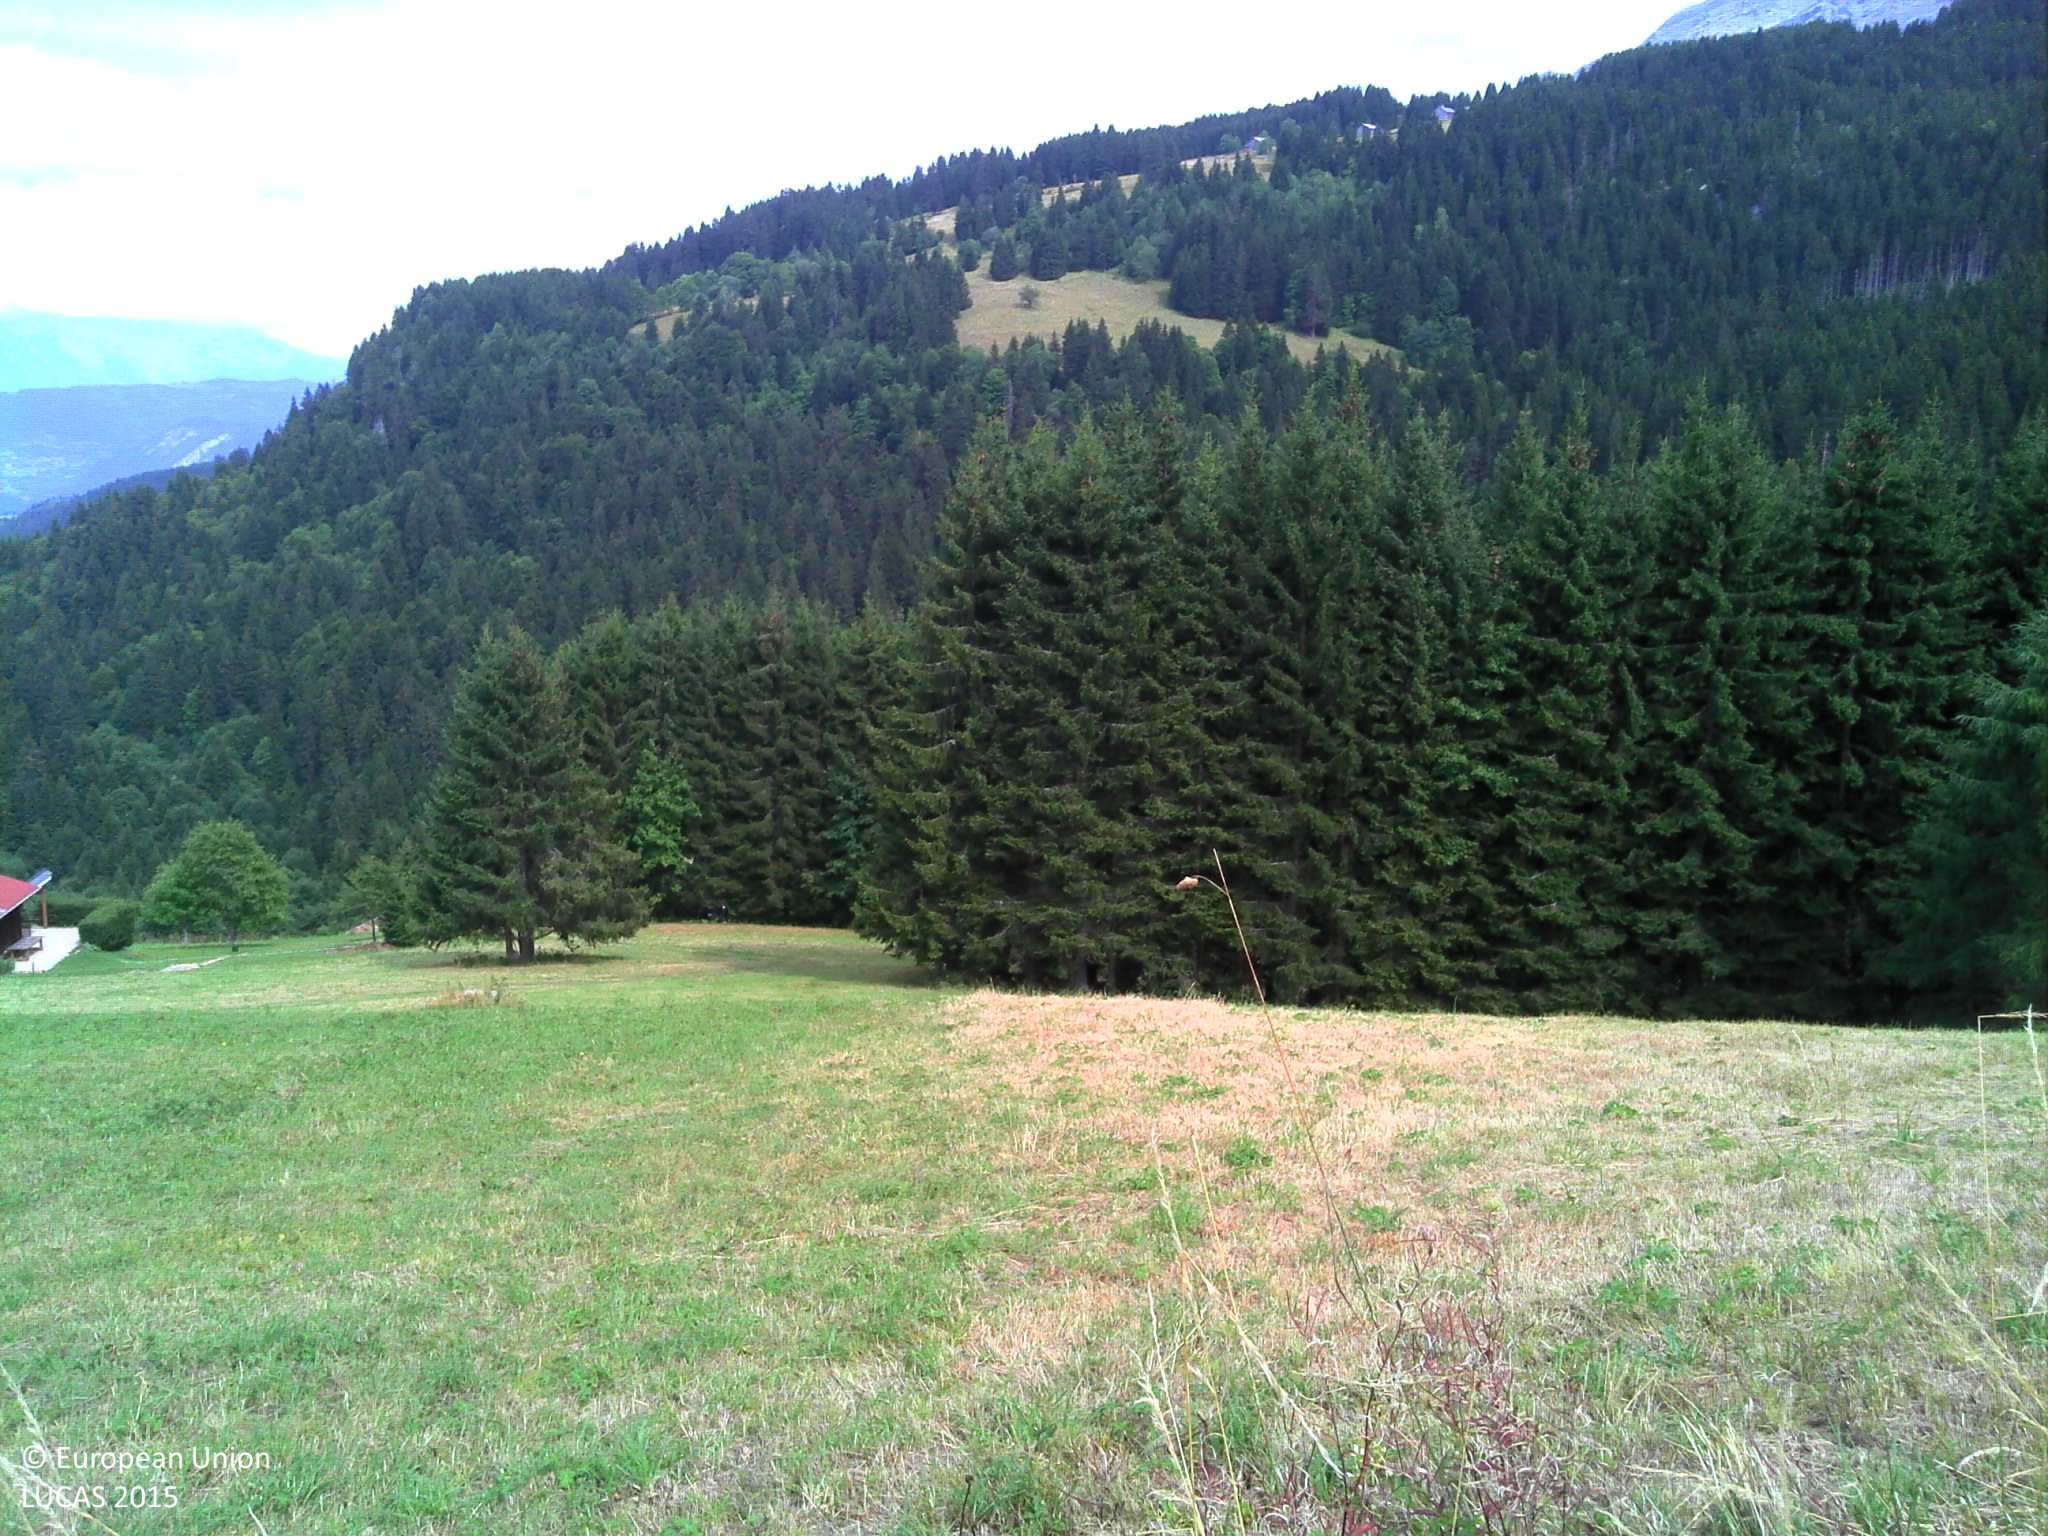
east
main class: Grassland
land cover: Spontaneously vegetated surfaces
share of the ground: > 75 %
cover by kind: herbaceous plants 100 %
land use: Semi-natural and natural areas not in use
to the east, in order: Spontaneously vegetated surfaces; Grassland without tree/shrub cover; Single bushes/trees; Grassland without tree/shrub cover; Spruce dominated coniferous woodland; Grassland without tree/shrub cover; Tracks; Single bushes/trees; Grassland without tree/shrub cover; Artificial constructions in urban areas; Grassland with sparse tree/shrub cover; Spontaneously vegetated surfaces; Grassland without tree/shrub cover; Dry stone walls; Grassland without tree/shrub cover; Tracks; Single bushes/trees; Grassland without tree/shrub cover
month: July
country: FR
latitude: 46.0399
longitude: 6.4502
